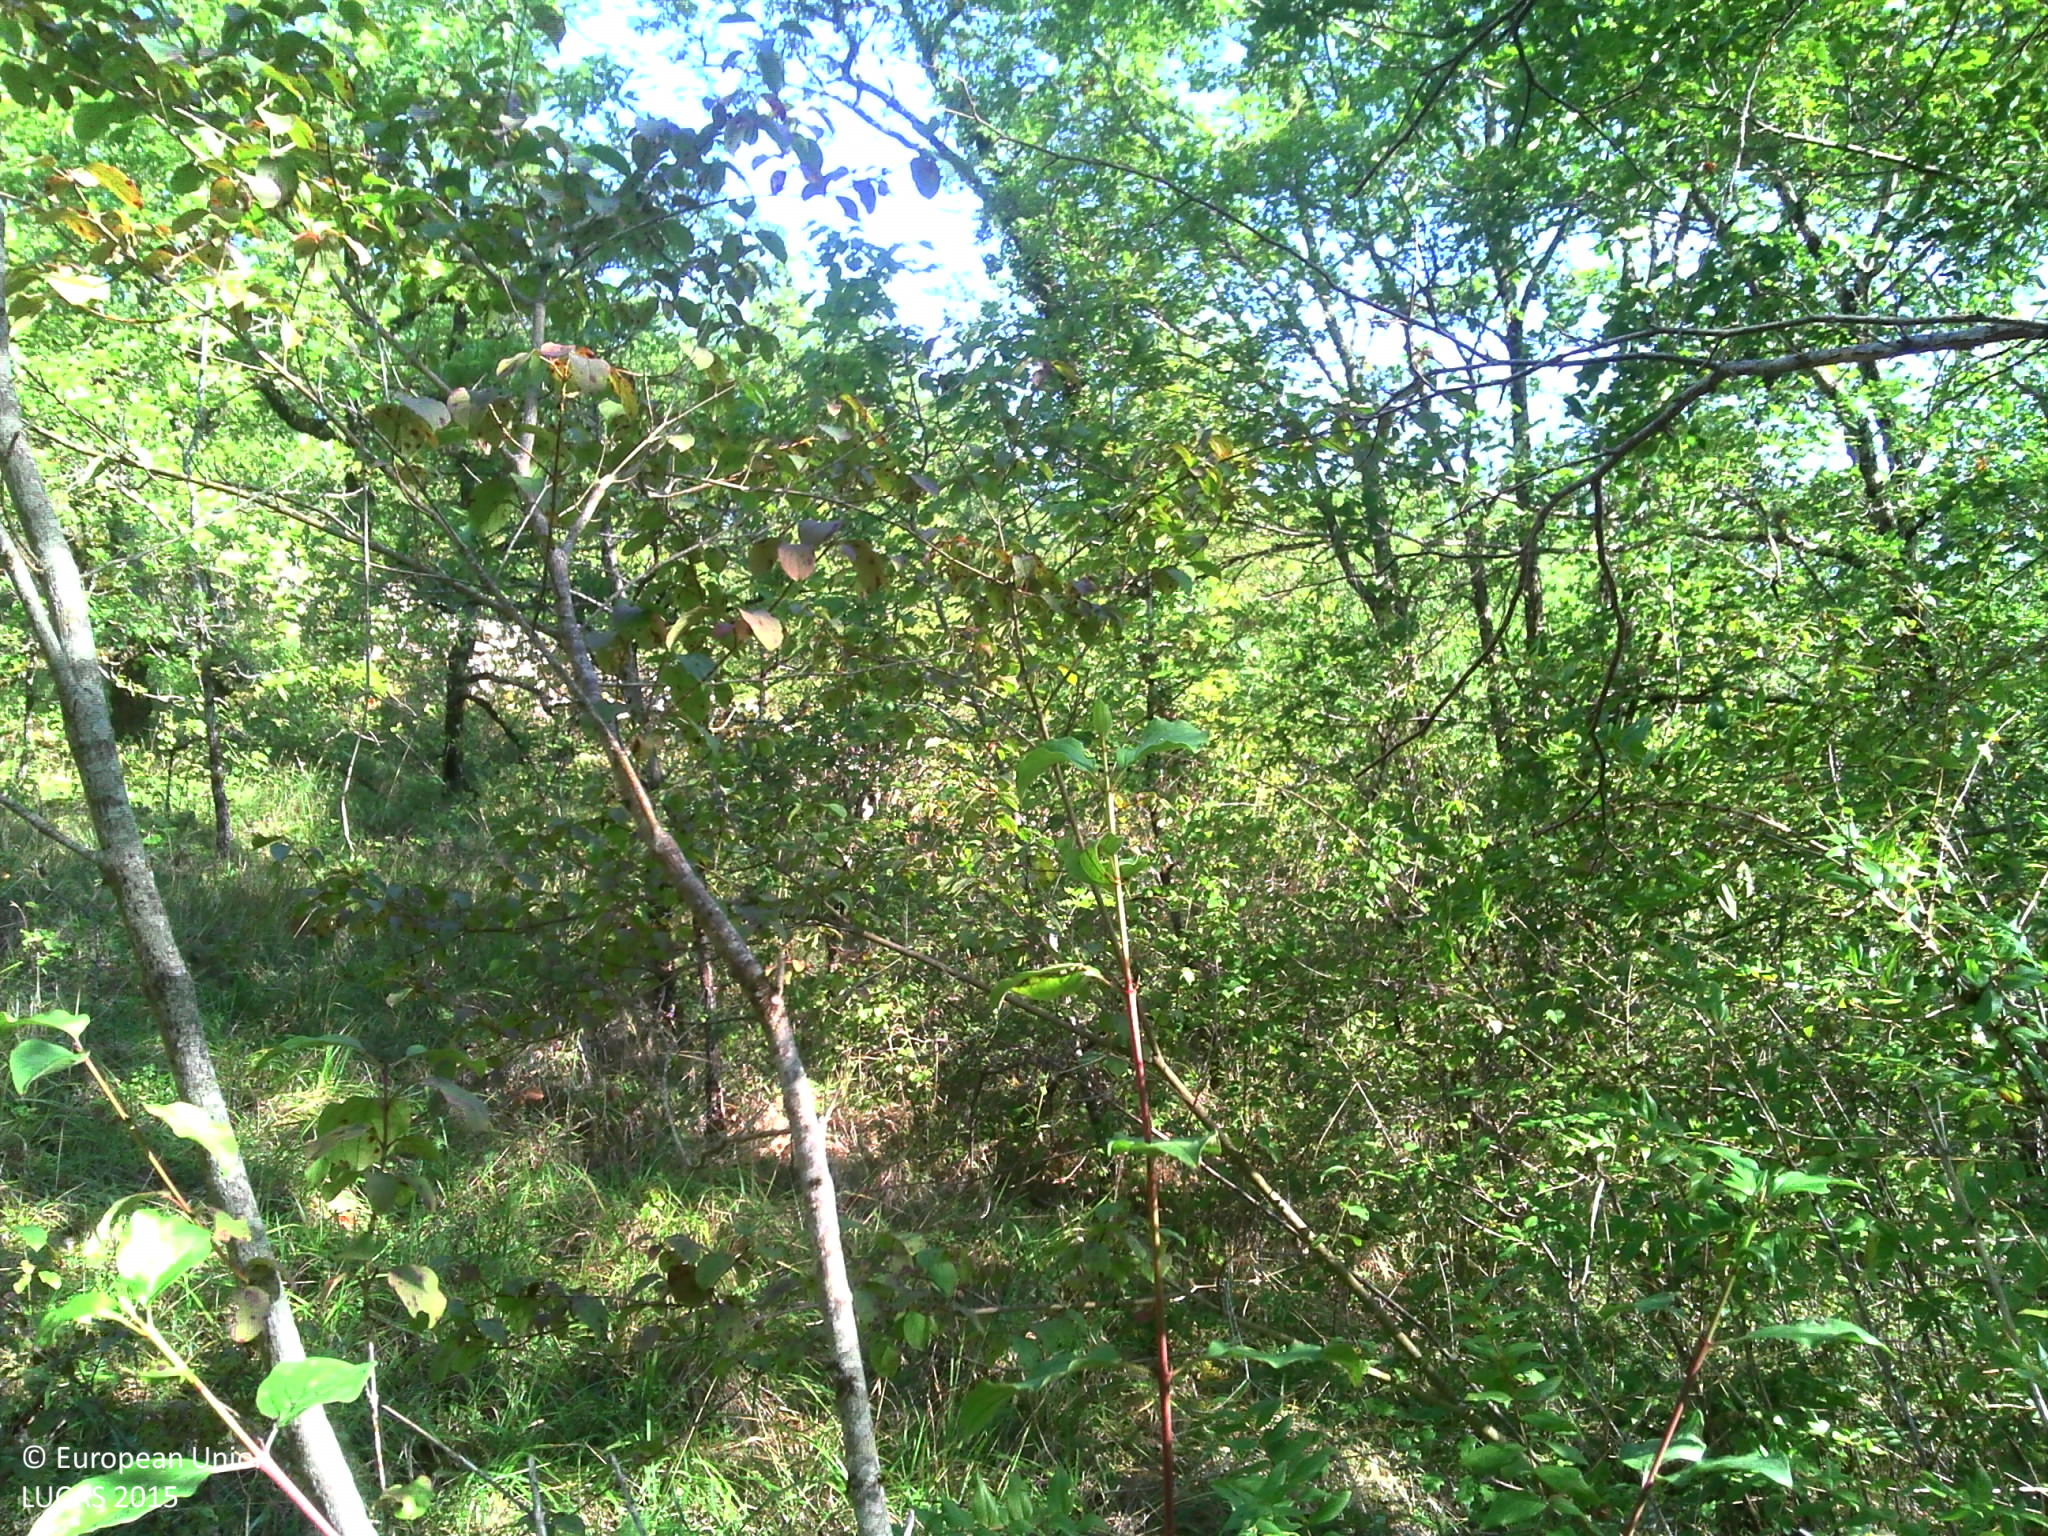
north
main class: Woodland
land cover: Broadleaved woodland
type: thermophilous deciduous forest
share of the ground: > 75 %
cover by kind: broadleaved forest trees 60 %, shrubs 20 %, herbaceous plants 20 %
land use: Forestry
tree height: > 5 m
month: September
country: FR
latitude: 44.6697
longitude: 1.2548
